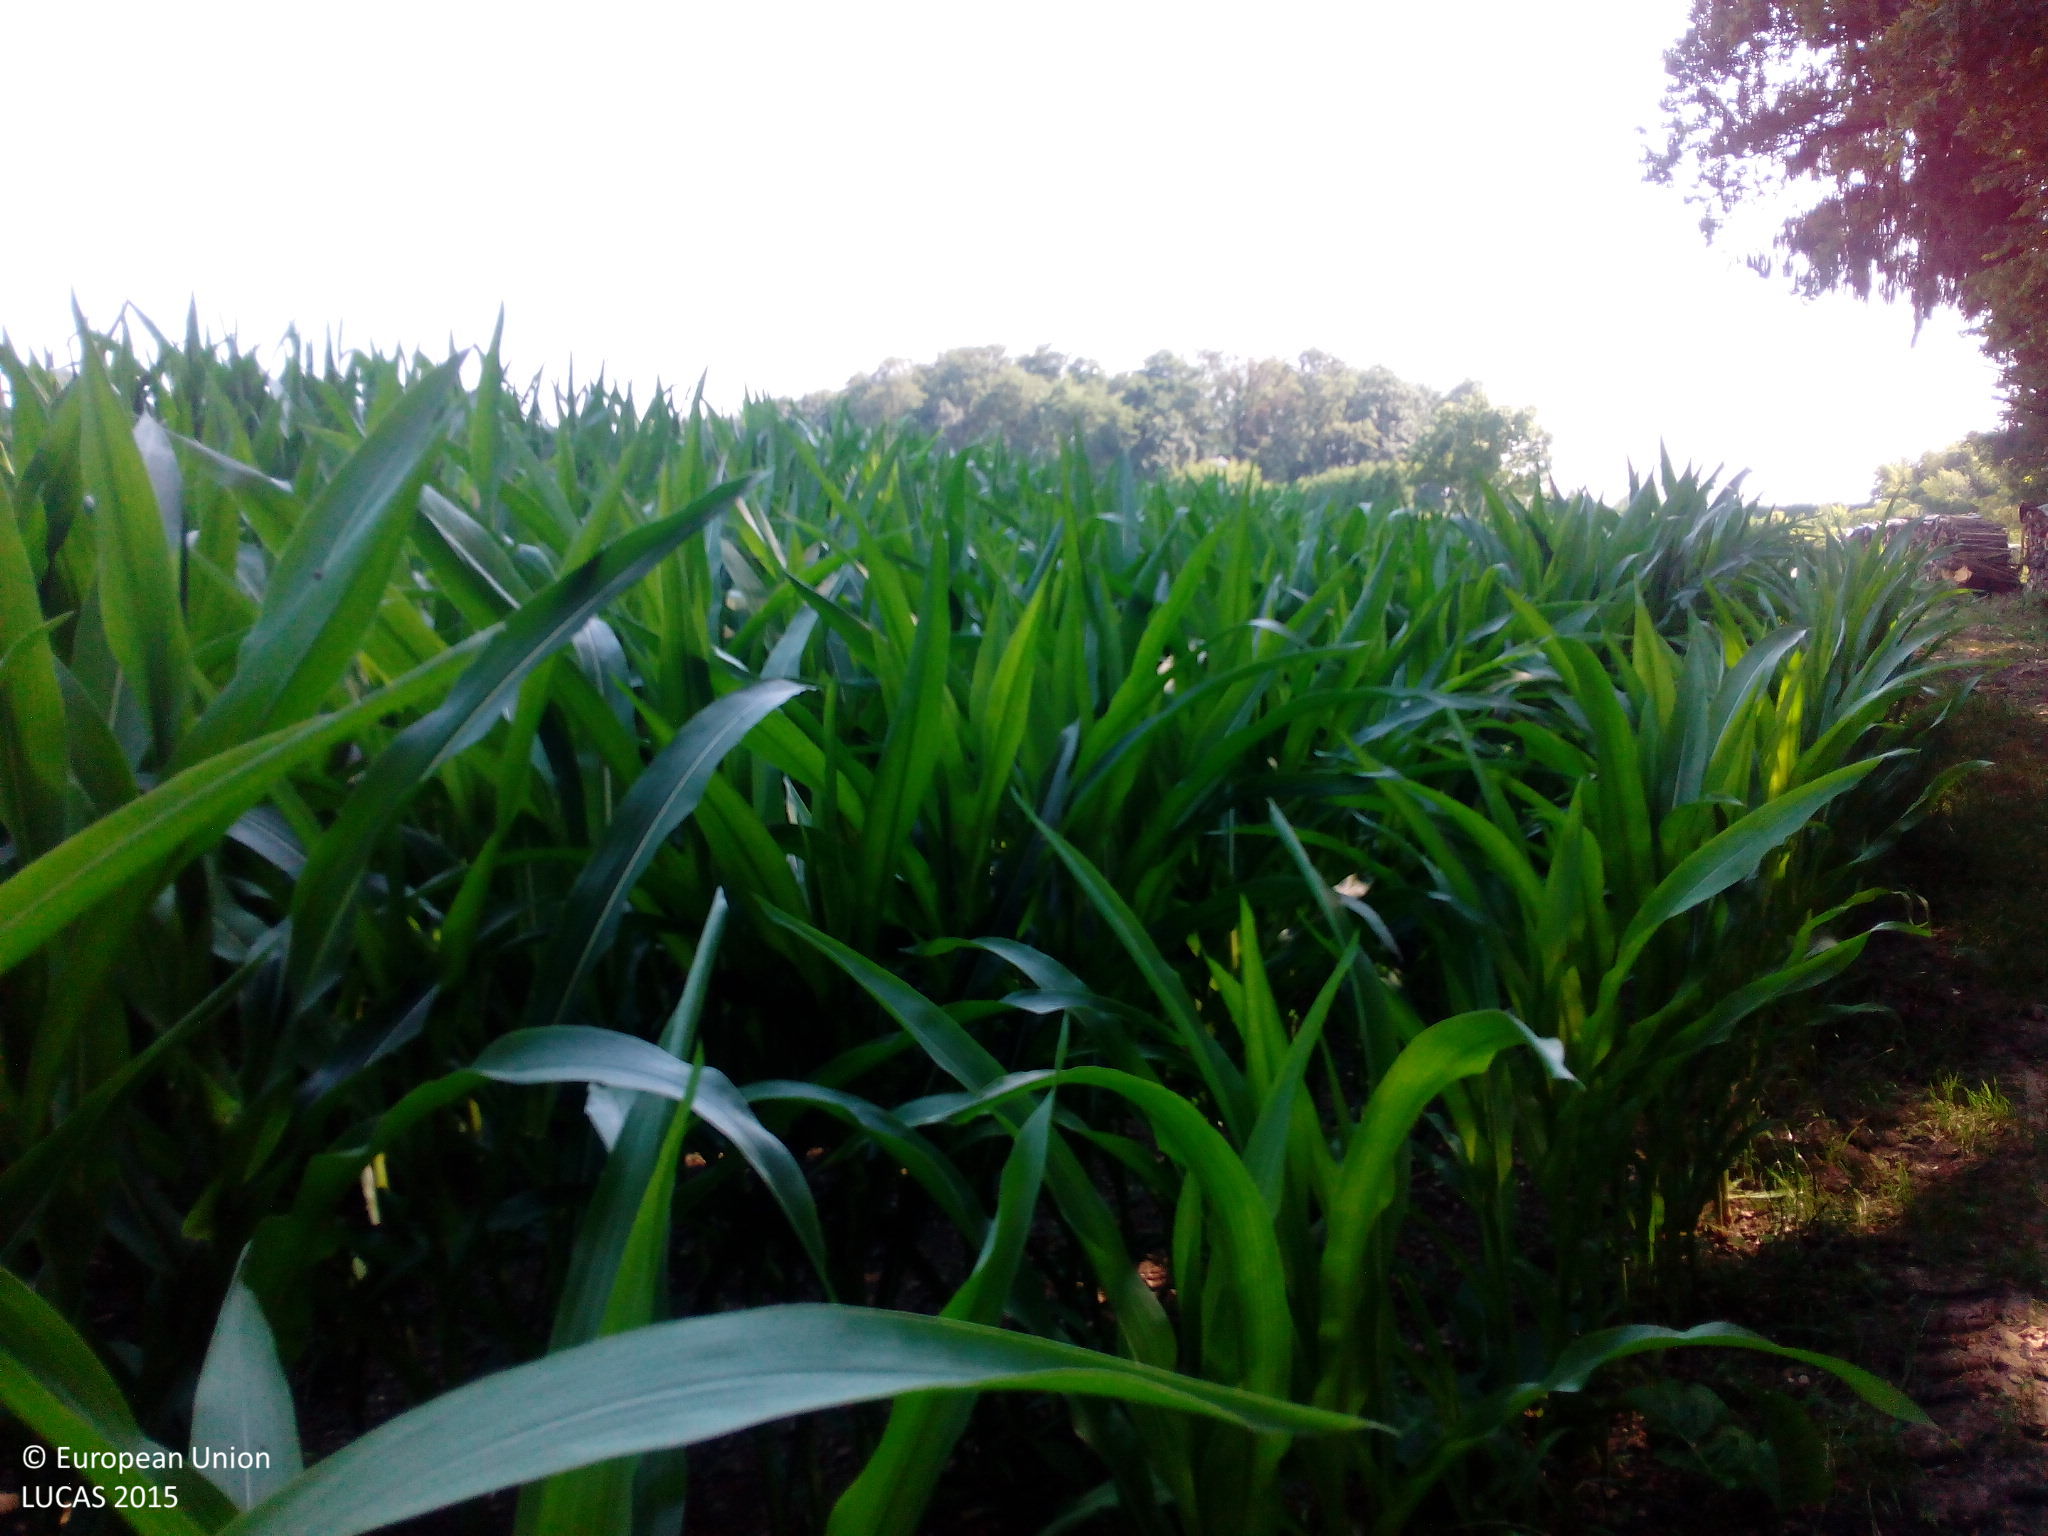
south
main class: Cropland
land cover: Maize
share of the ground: > 75 %
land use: Agriculture (excluding fallow land and kitchen gardens)
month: July
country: DE
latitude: 48.2216
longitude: 12.8930
